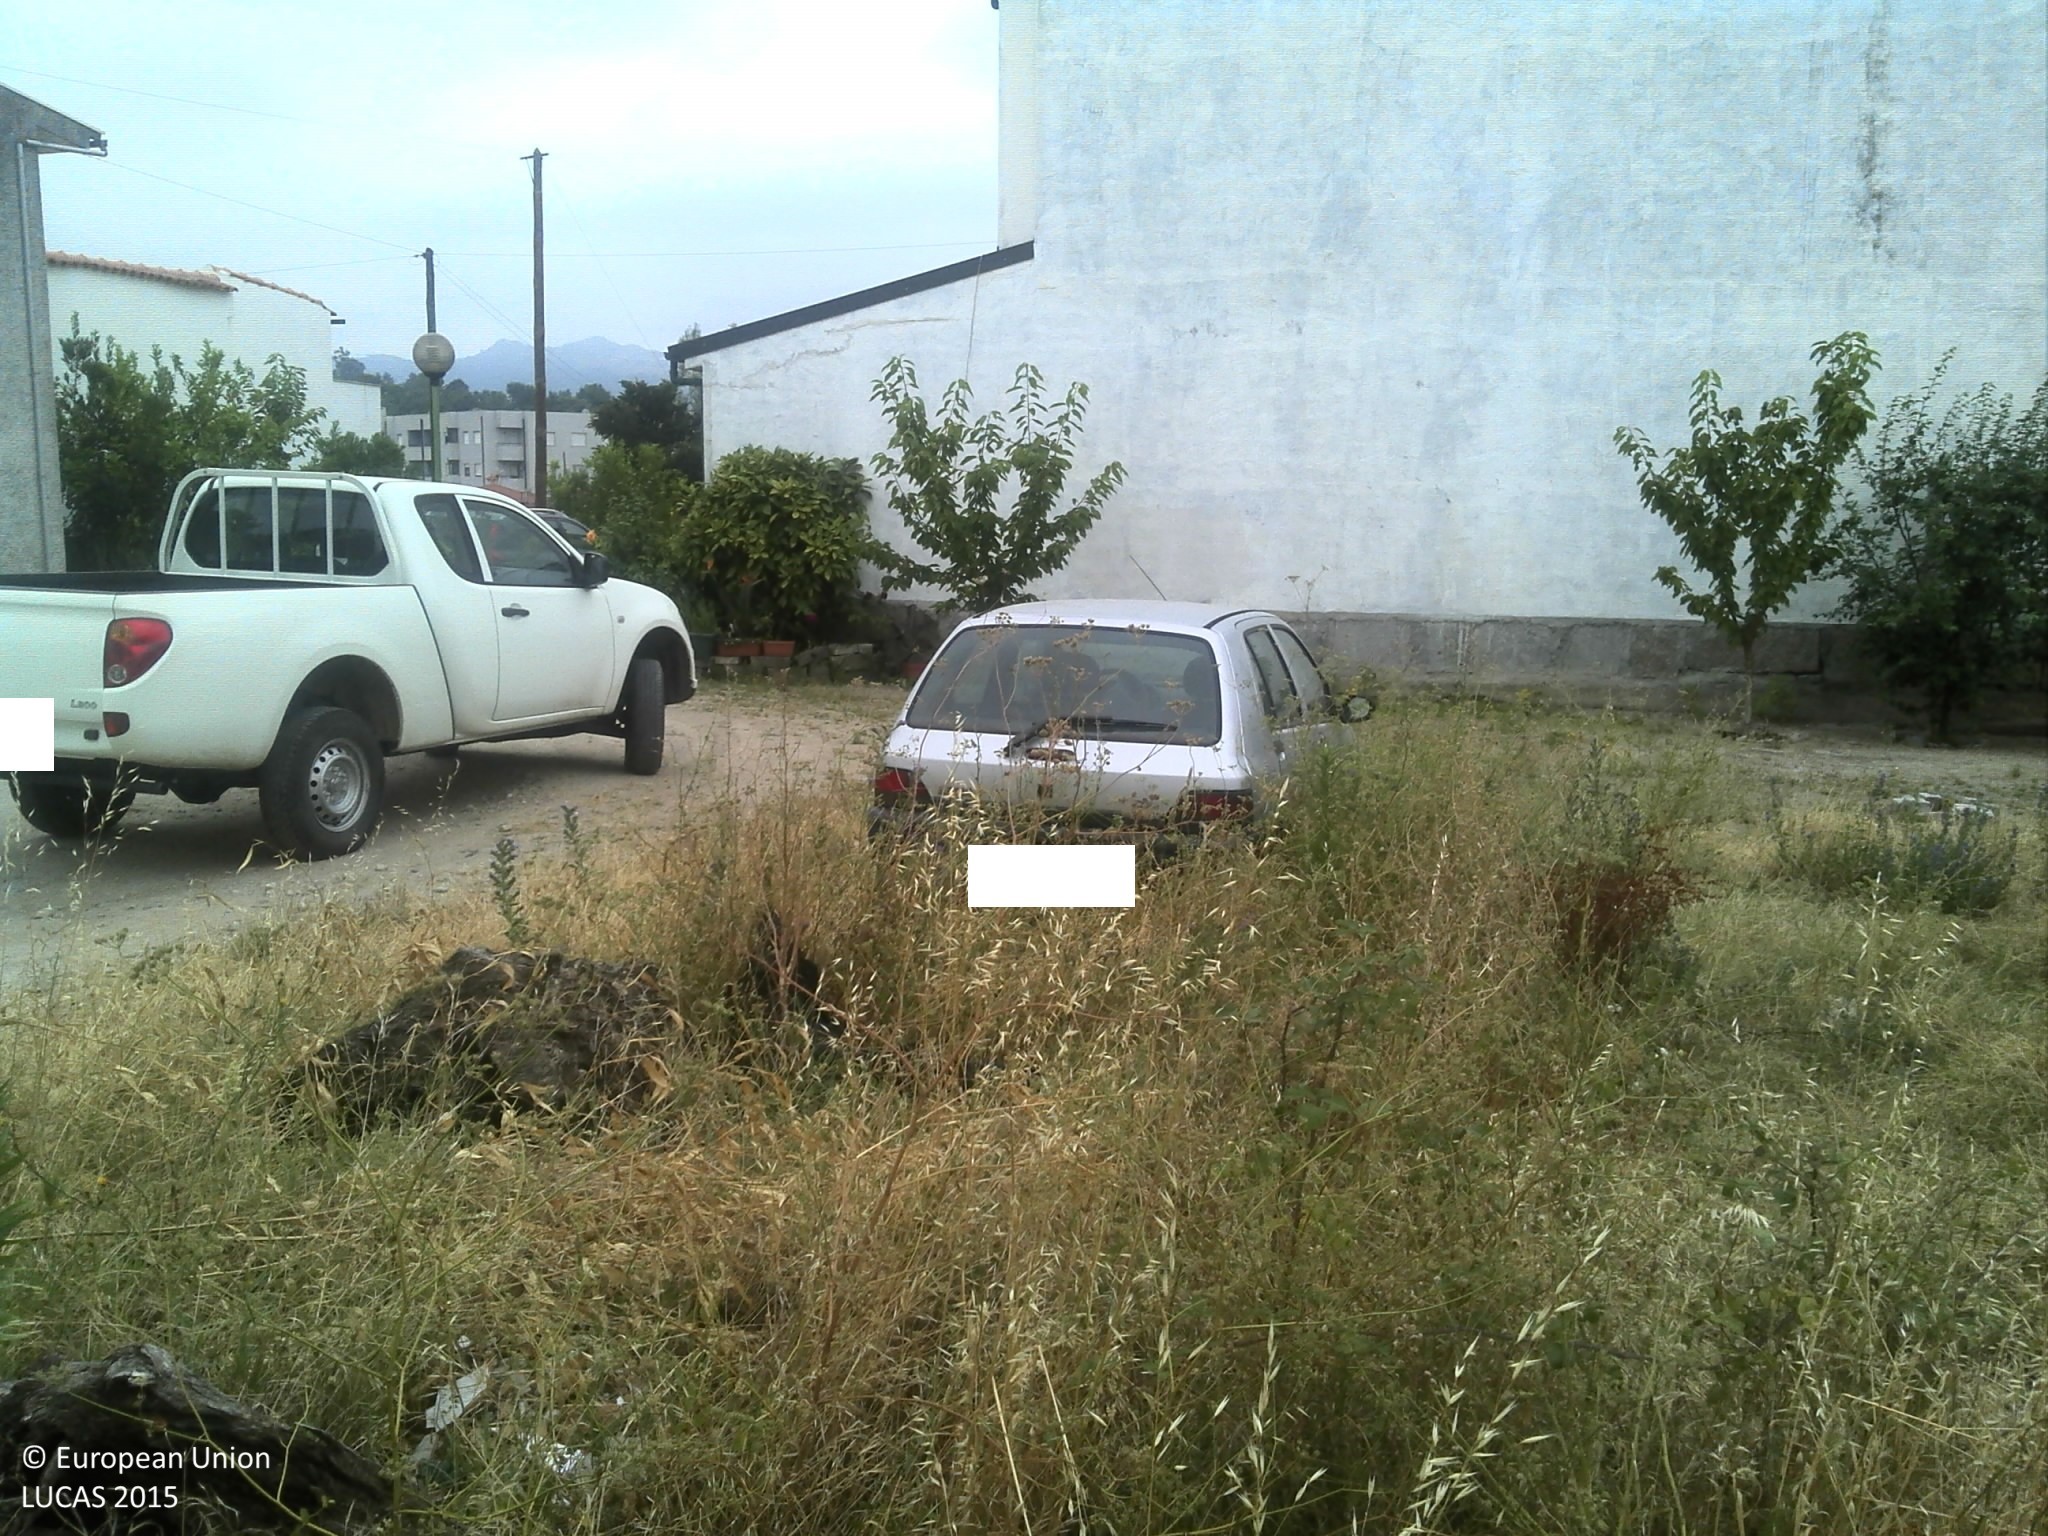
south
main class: Shrubland
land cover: Shrubland without tree cover
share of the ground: 50 - 75 %
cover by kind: herbaceous plants 60 %, unconsolidated bare surface 25 %, shrubs 15 %
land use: Residential
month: June
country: PT
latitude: 41.1820
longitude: -8.1530
